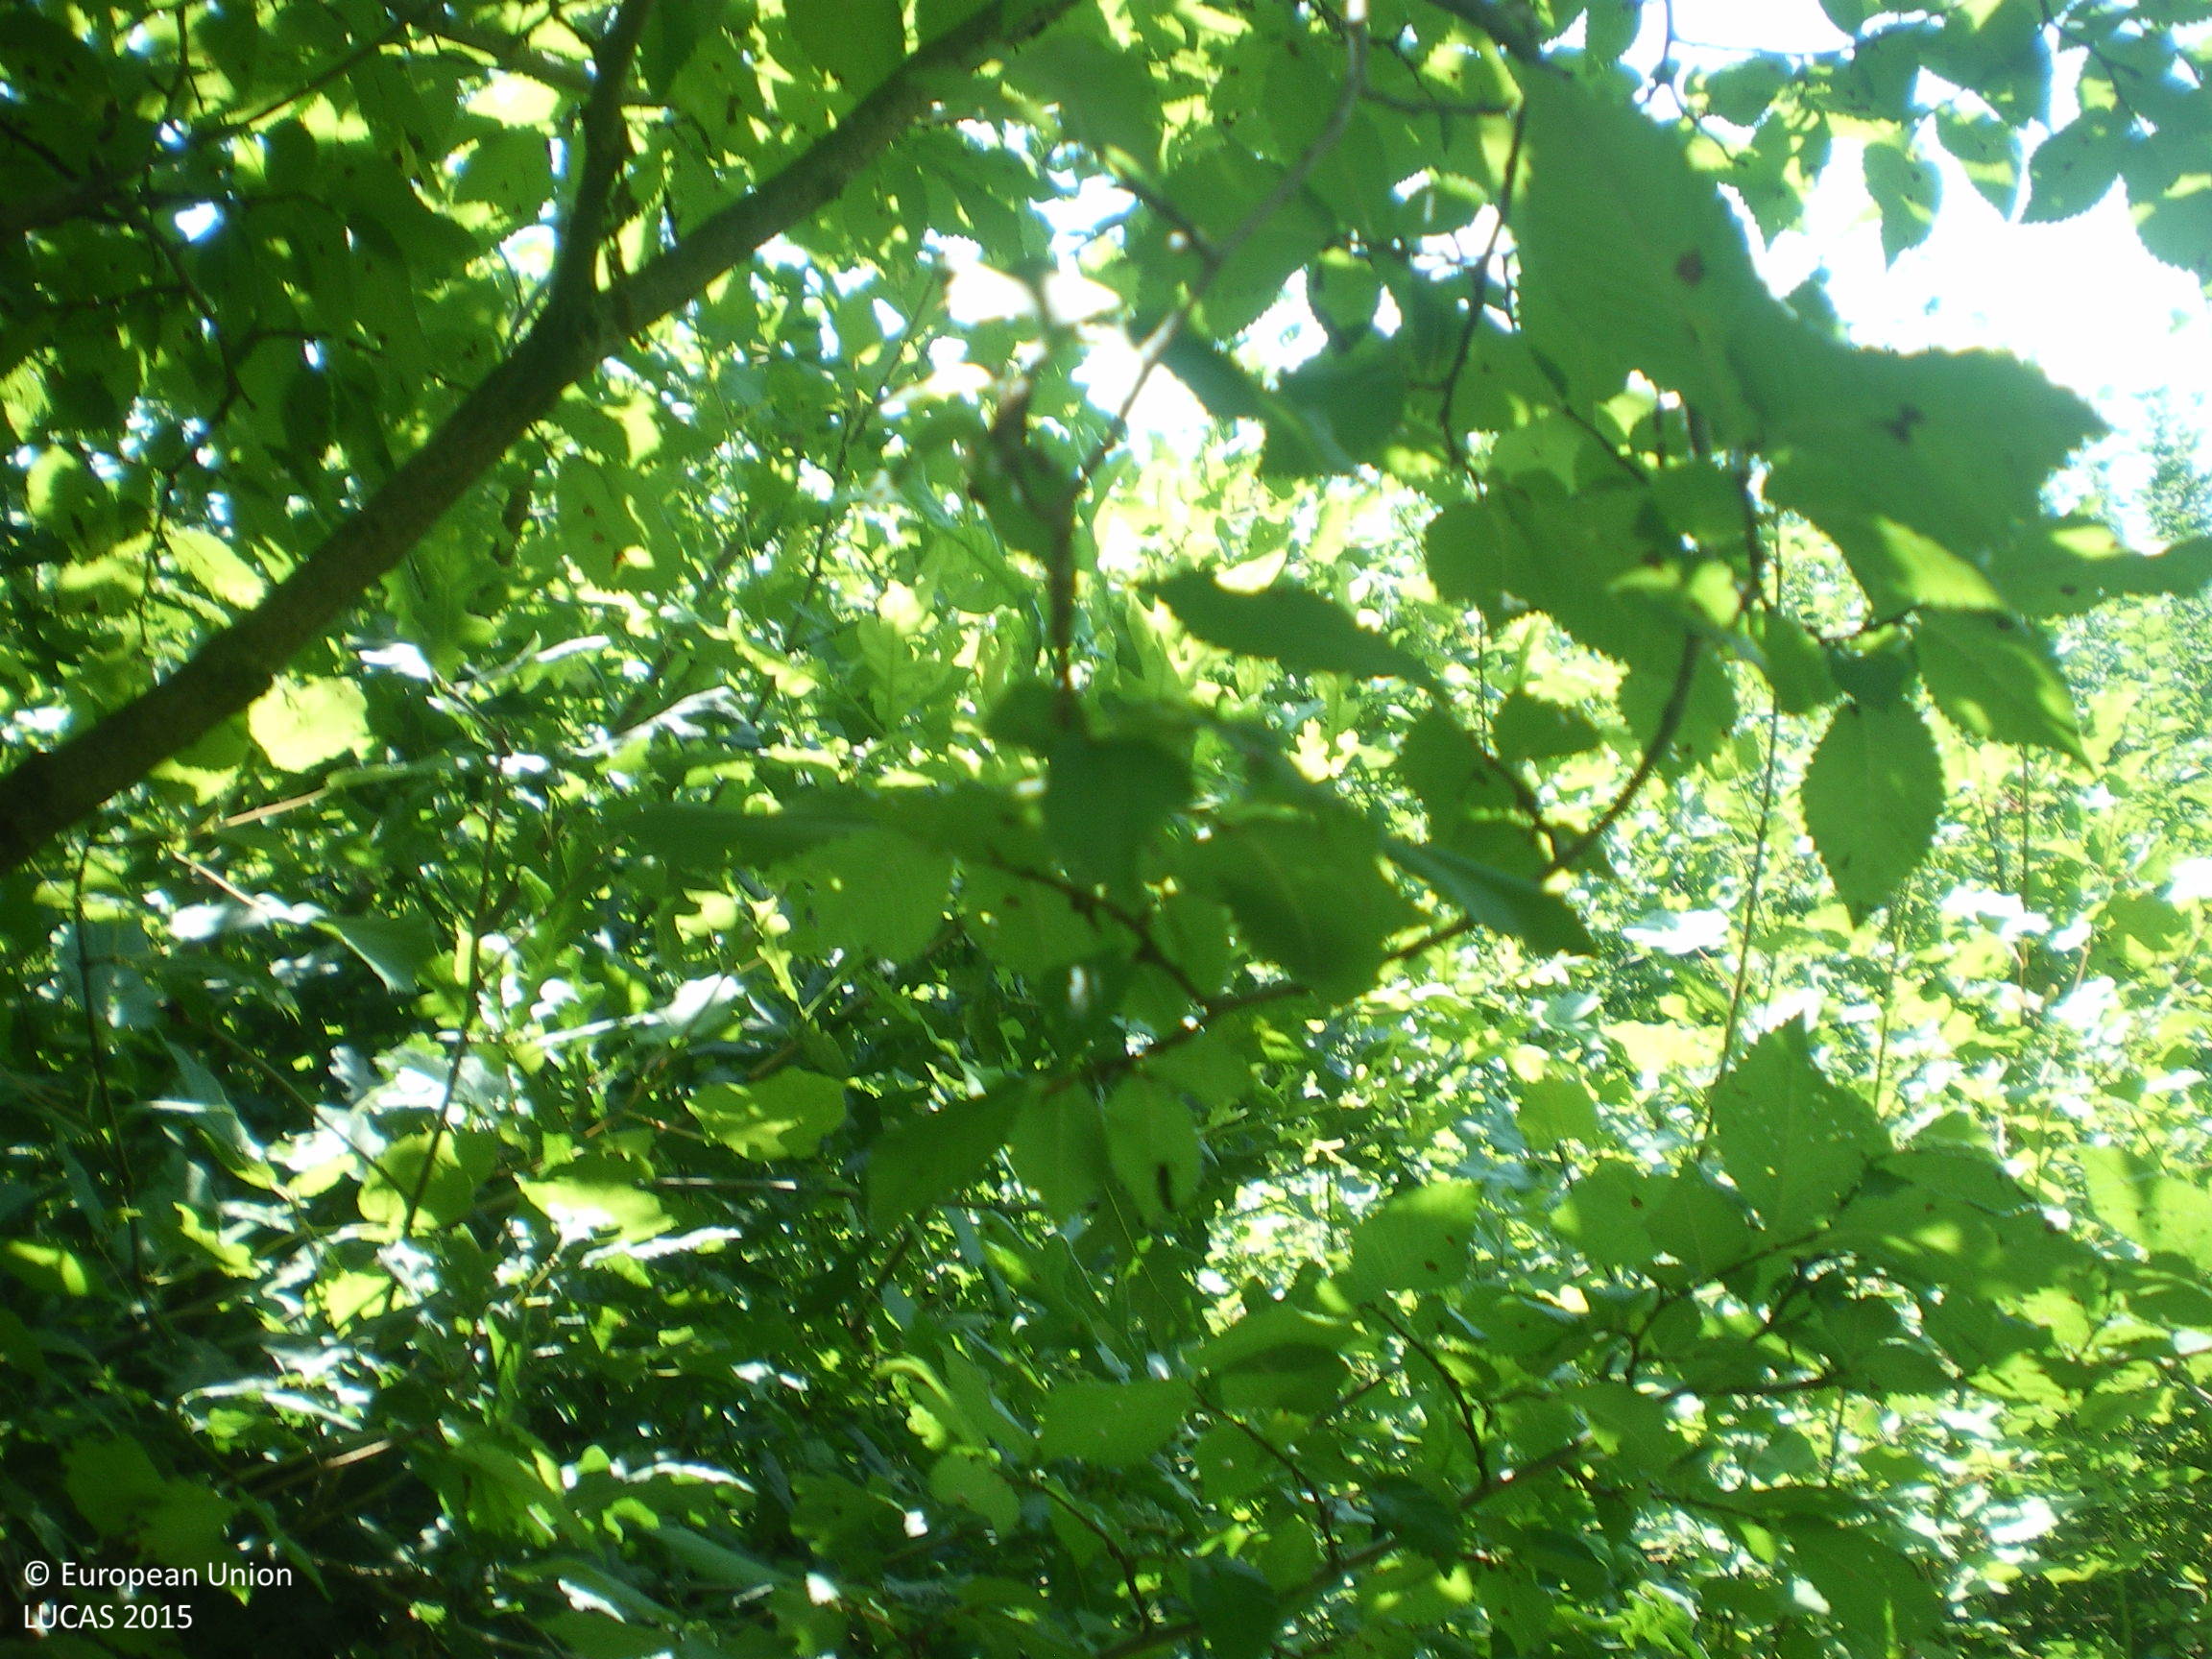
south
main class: Woodland
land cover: Broadleaved woodland
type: mesophytic deciduous forest
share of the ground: > 75 %
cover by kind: broadleaved forest trees 95 %, shrubs 5 %
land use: Forestry
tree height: > 5 m
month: July
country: BG
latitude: 42.4054
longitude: 25.8597
